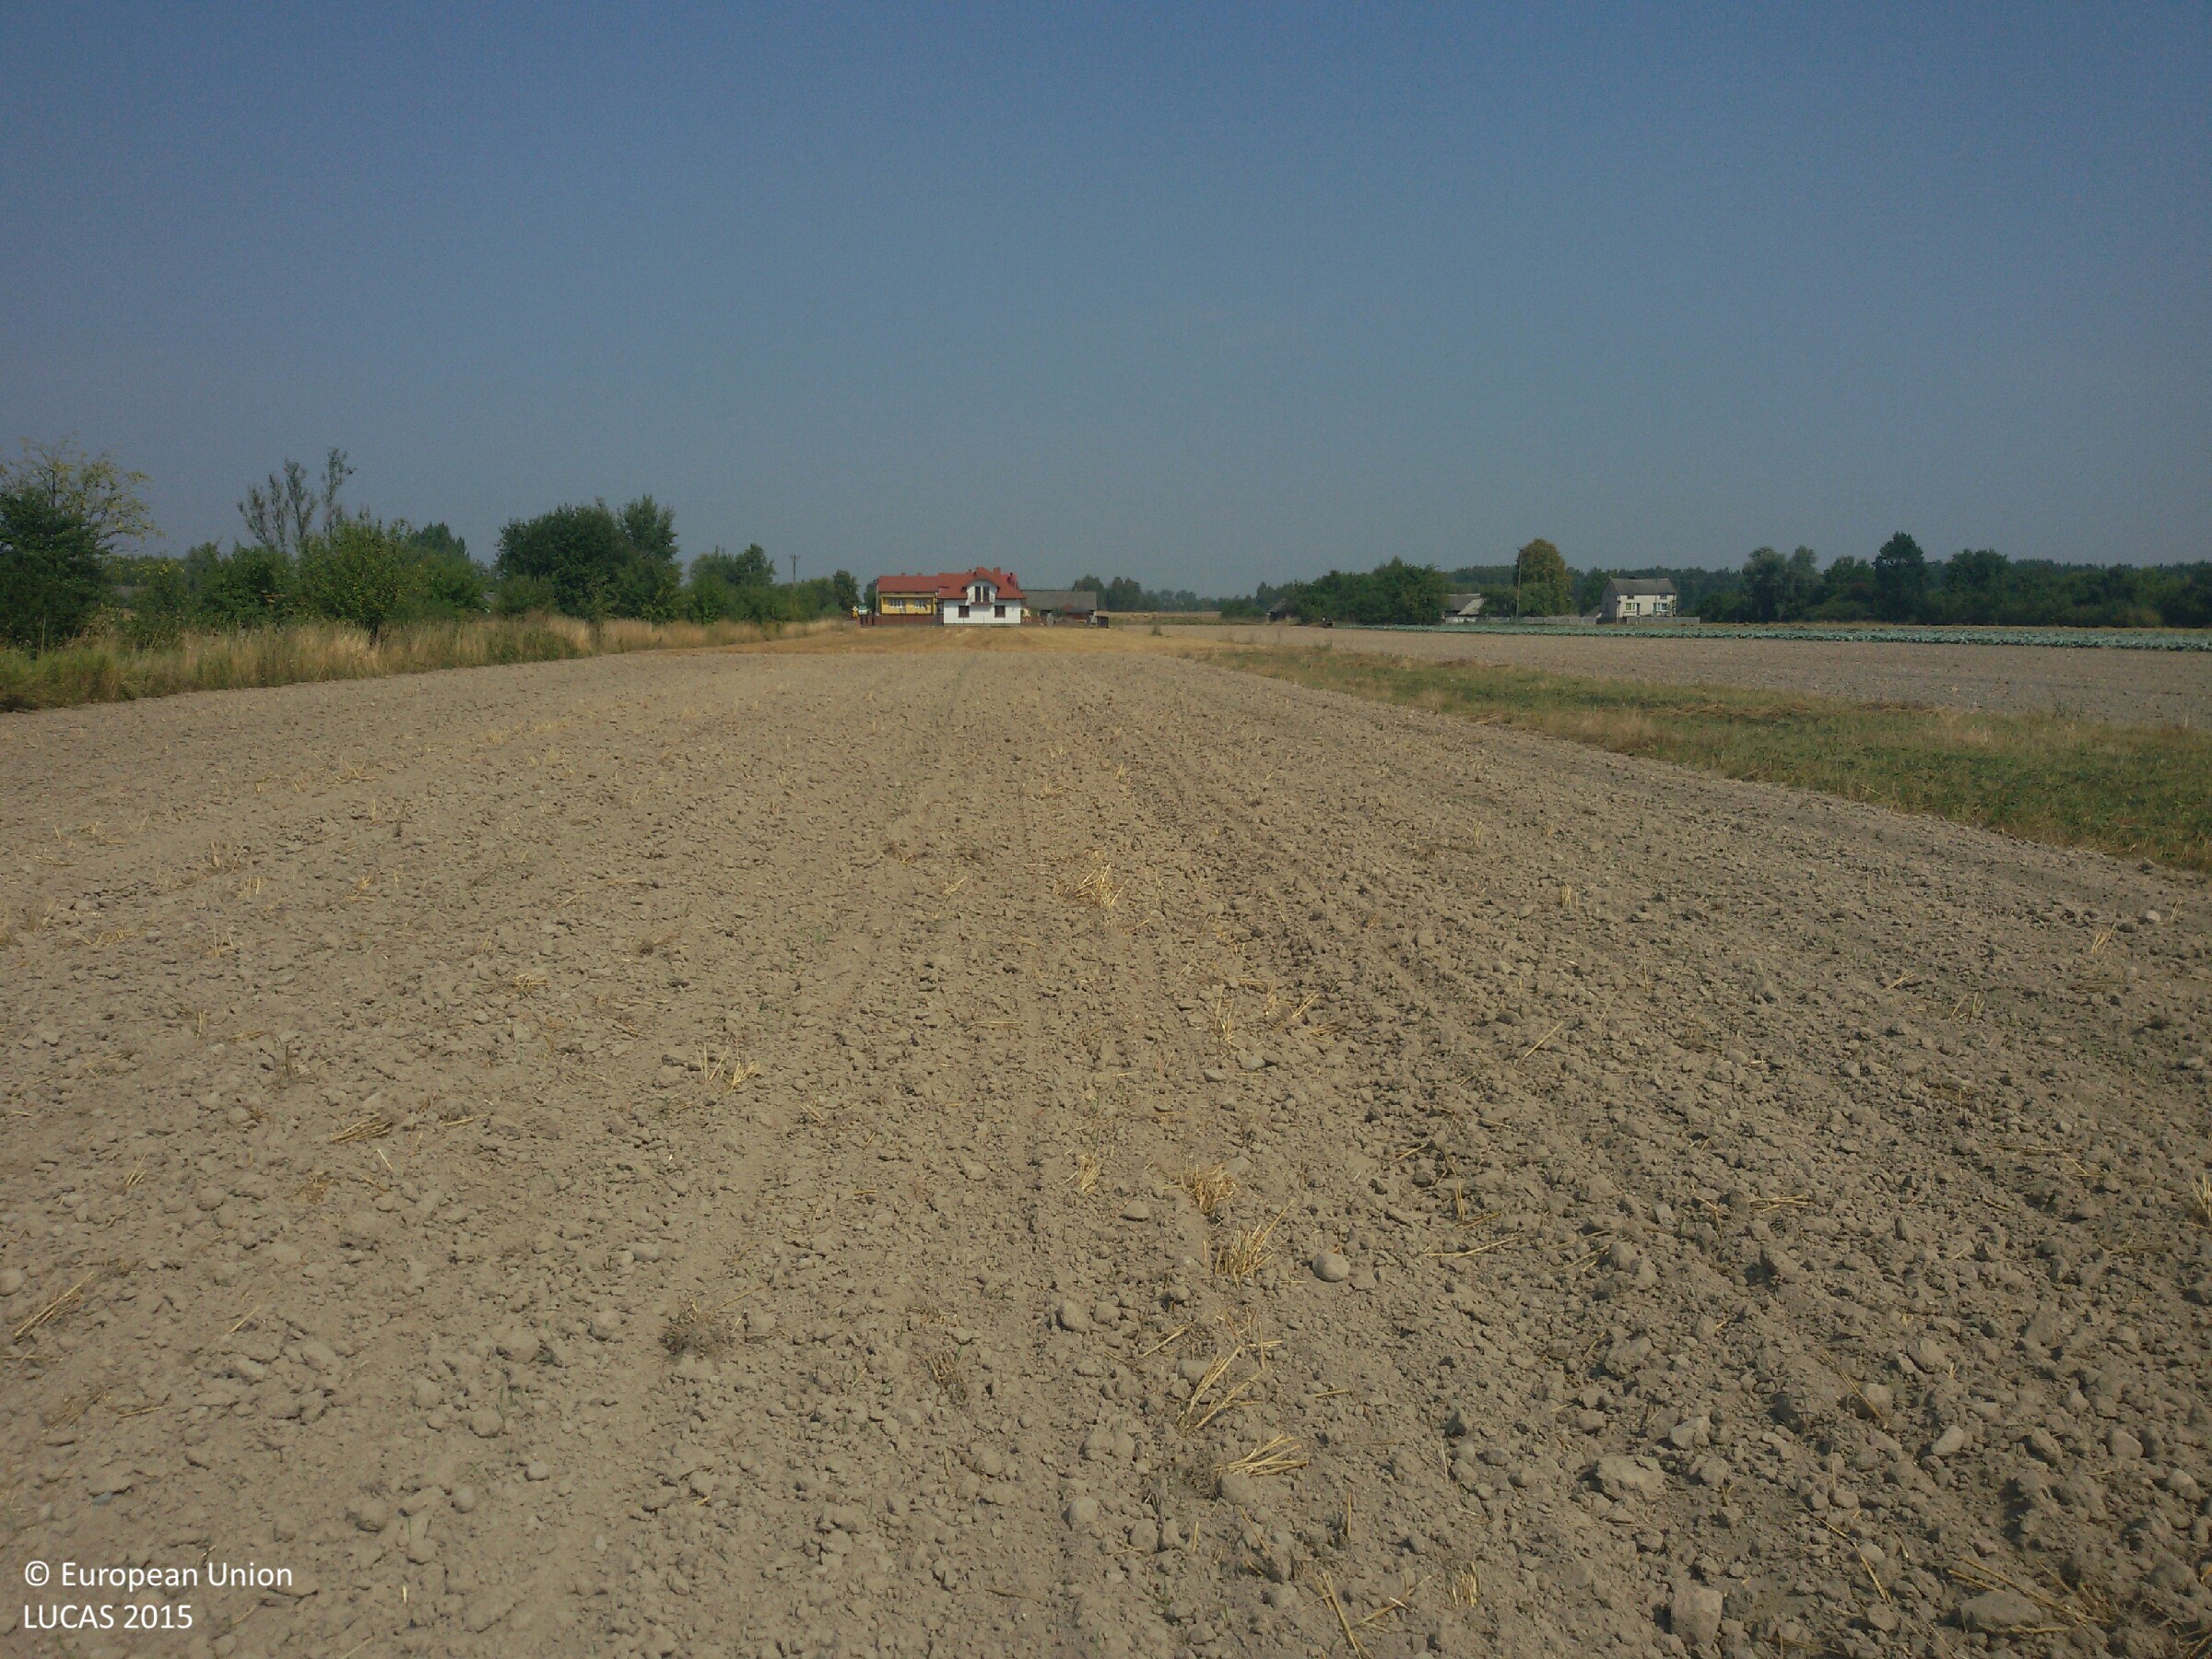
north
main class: Cropland
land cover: Rye
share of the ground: < 10 %
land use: Agriculture (excluding fallow land and kitchen gardens)
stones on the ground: < 10 %
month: August
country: PL
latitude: 51.3084
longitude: 20.9317
